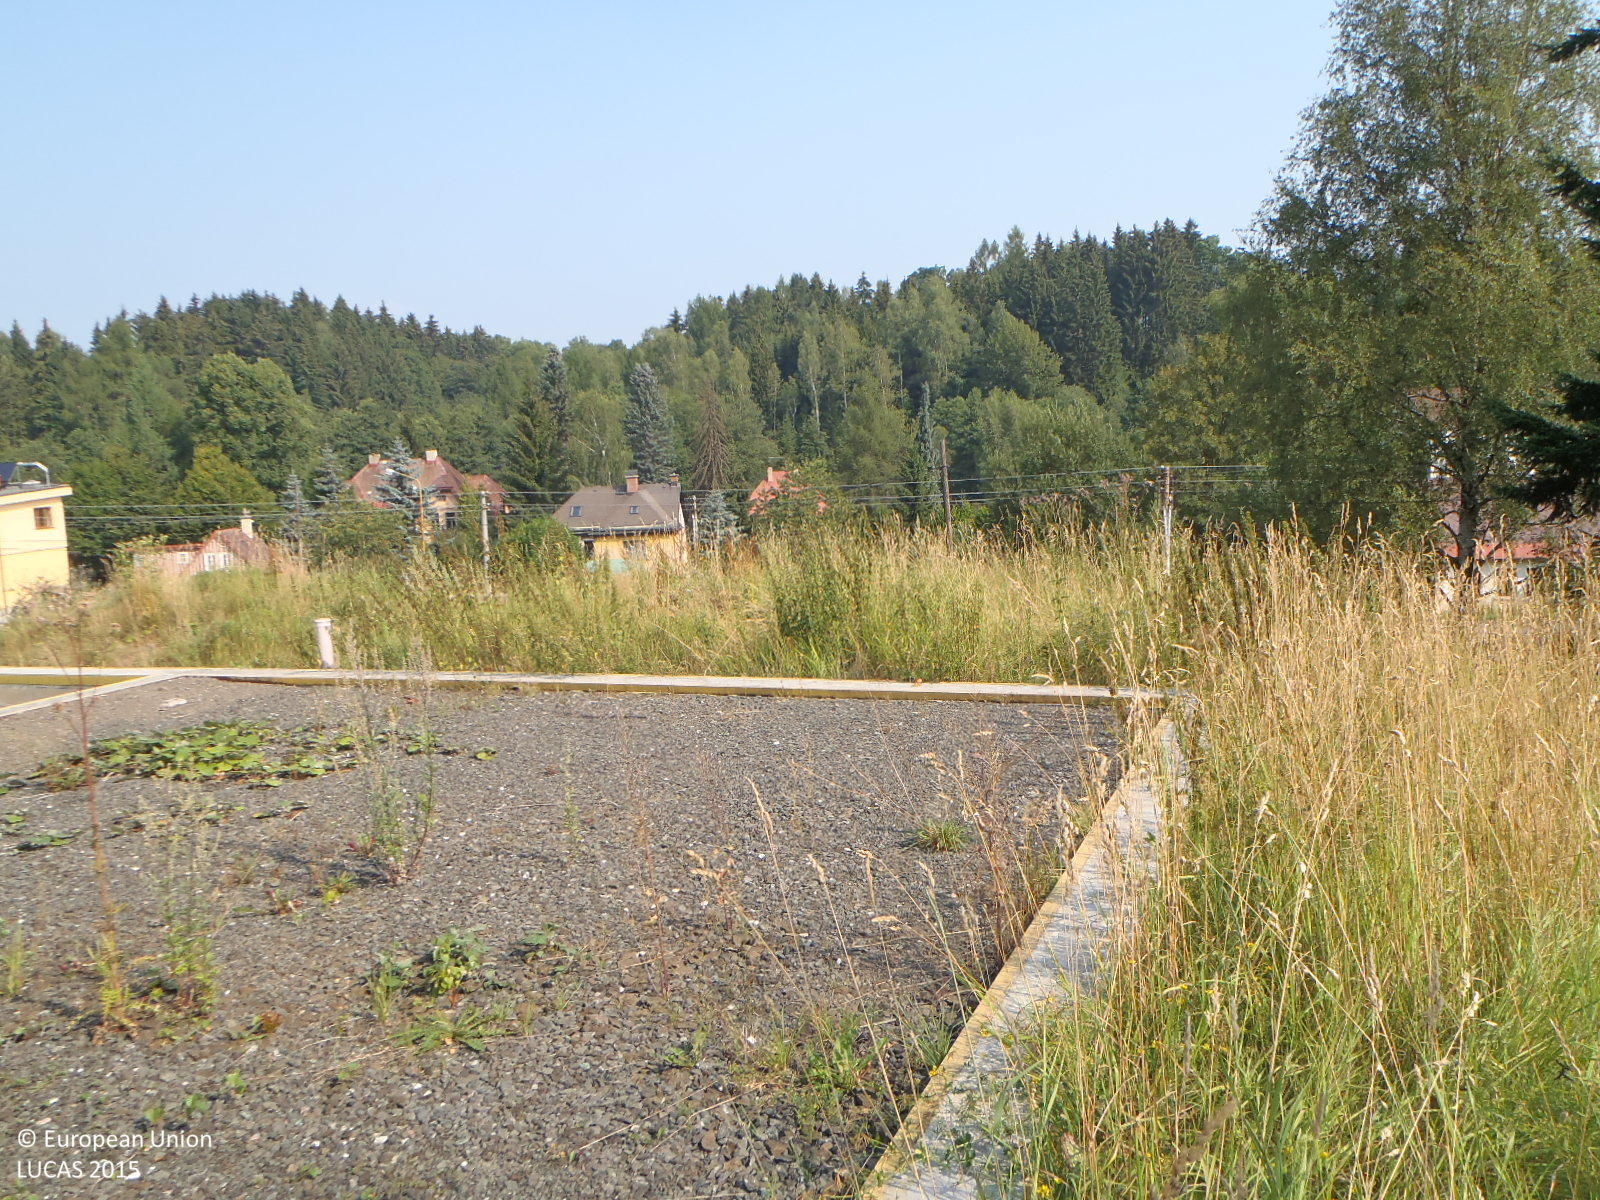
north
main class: Grassland
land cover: Spontaneously vegetated surfaces
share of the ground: > 75 %
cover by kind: herbaceous plants 100 %
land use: Coal, oil and metal processing
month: August
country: CZ
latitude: 50.7296
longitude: 15.2596
